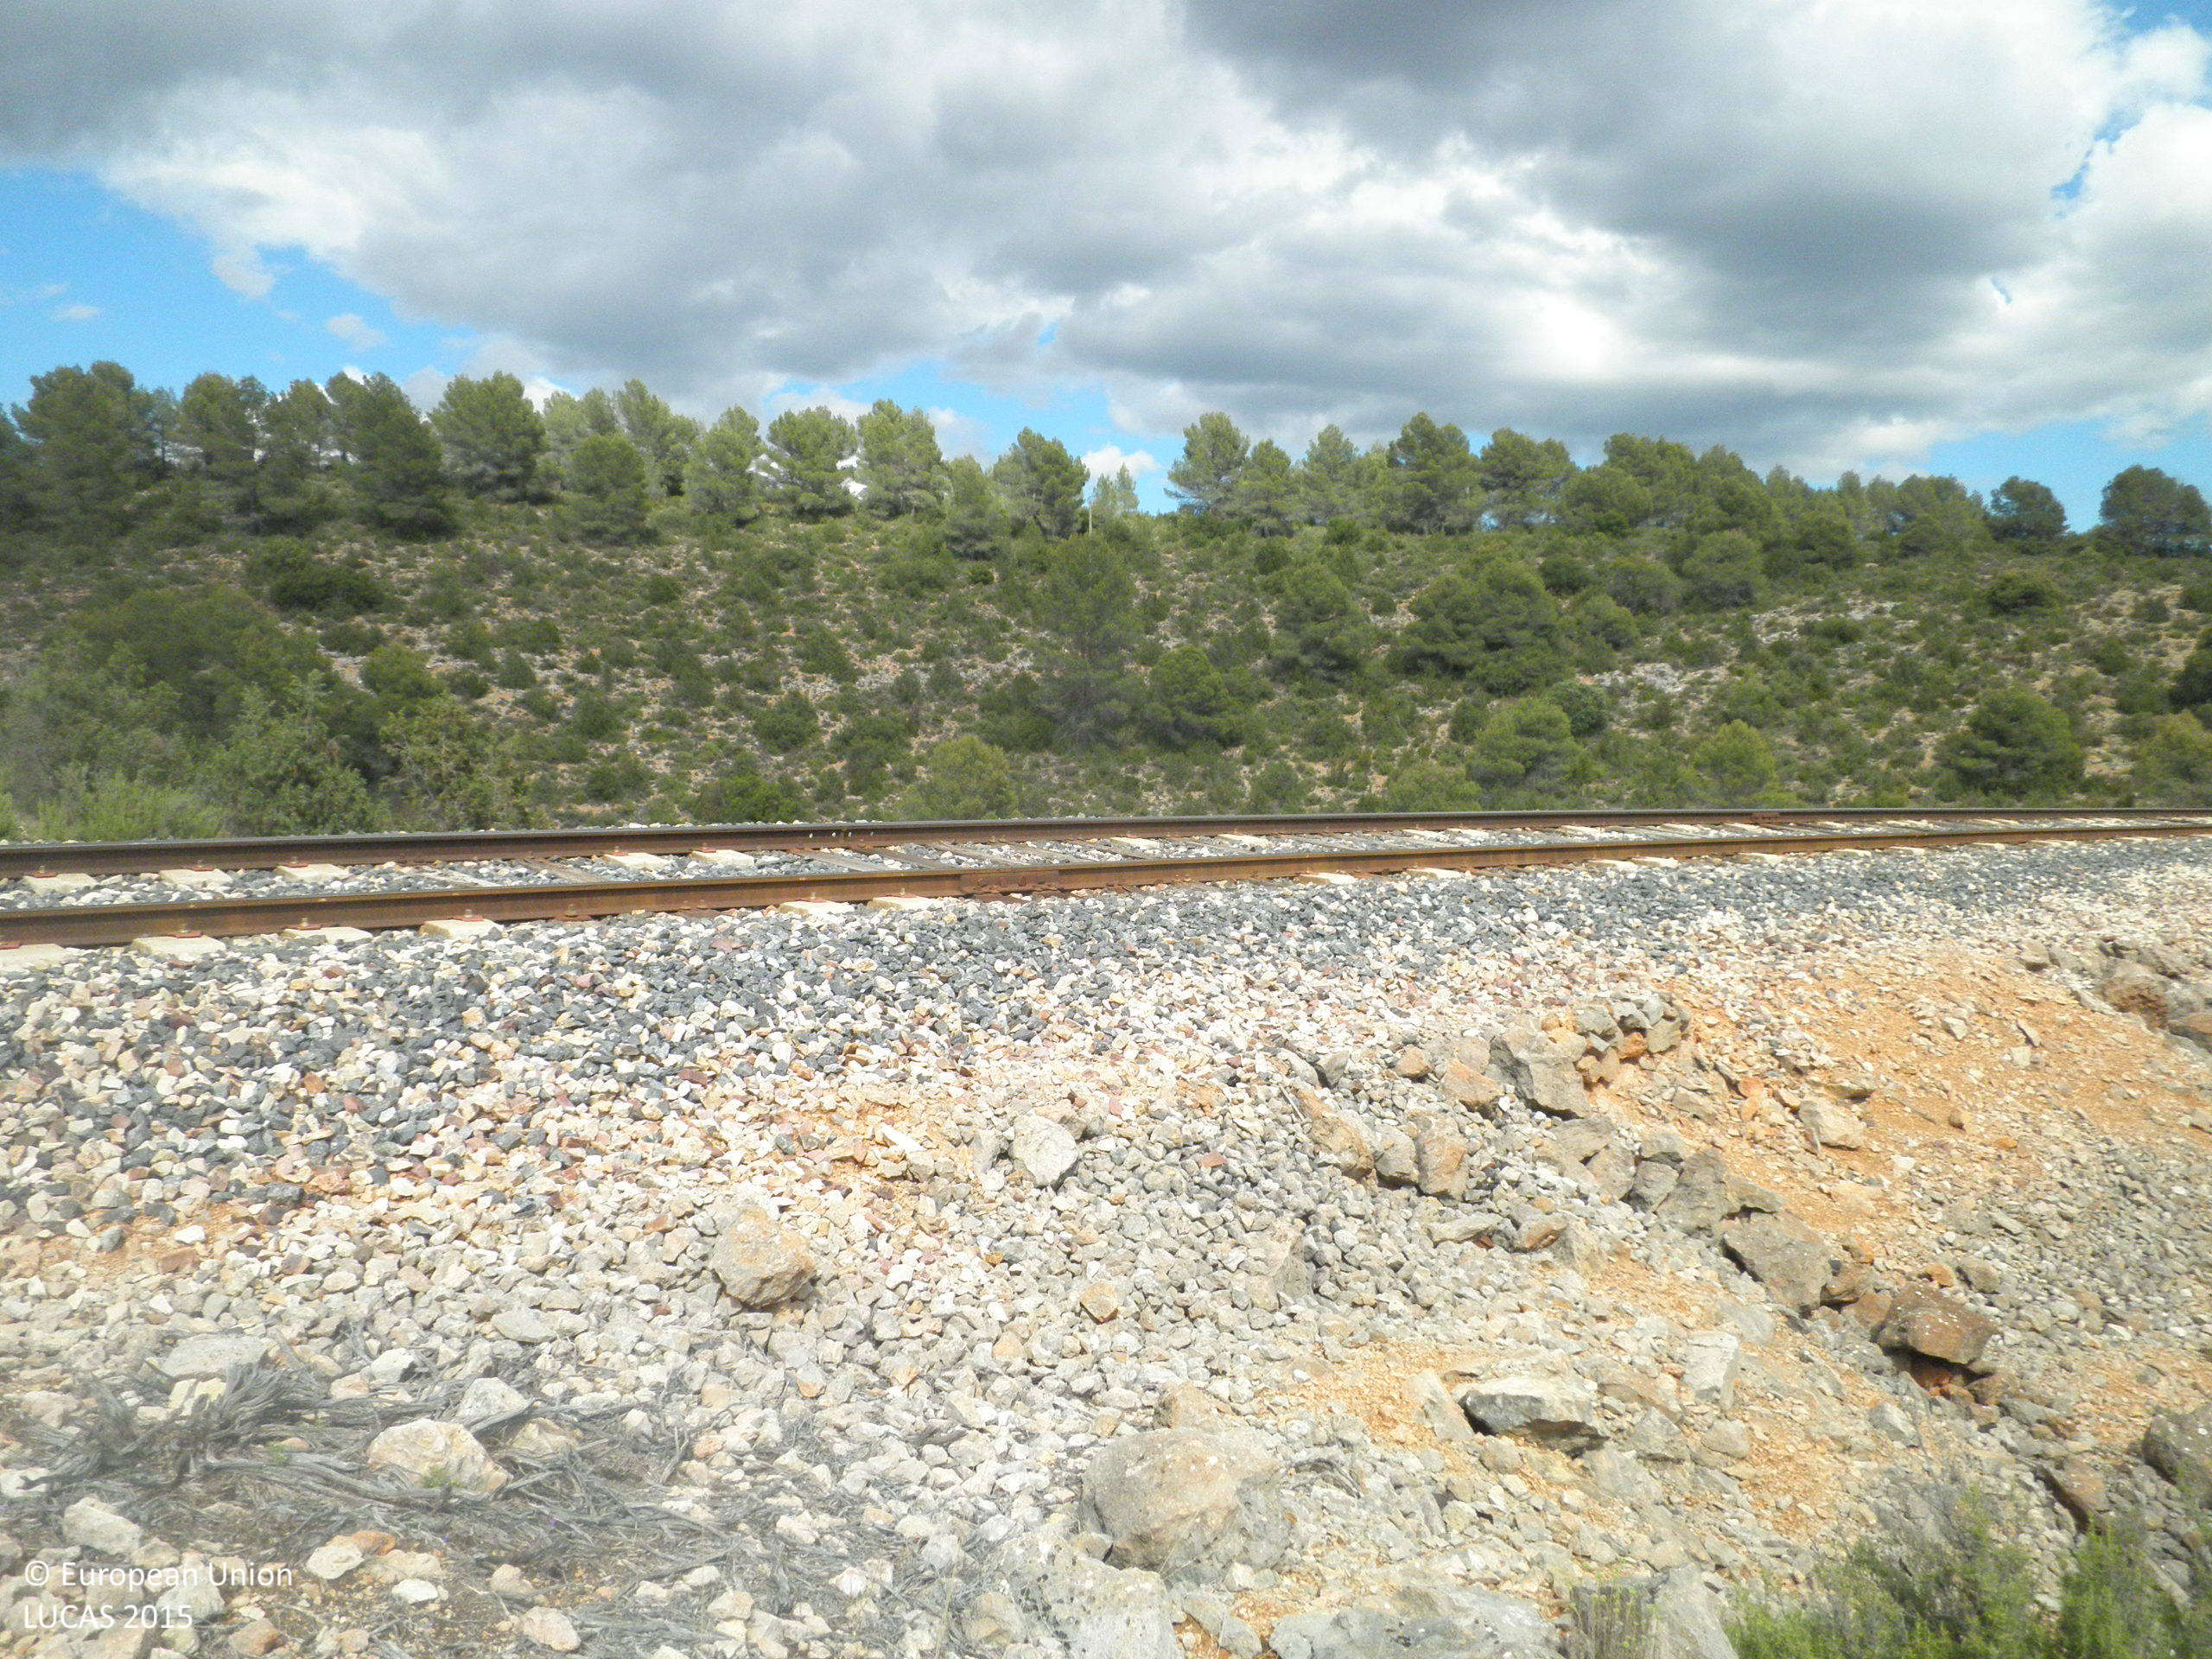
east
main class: Shrubland
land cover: Shrubland without tree cover
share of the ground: 25 - 50 %
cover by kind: unconsolidated bare surface 60 %, shrubs 30 %, herbaceous plants 10 %
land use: Semi-natural and natural areas not in use
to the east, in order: Shrubland without tree cover; Other bare soil; Railways; Other bare soil; Shrubland without tree cover; Pine dominated coniferous woodland; Shrubland without tree cover; Pine dominated coniferous woodland
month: June
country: ES
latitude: 39.7636
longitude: -1.7168
